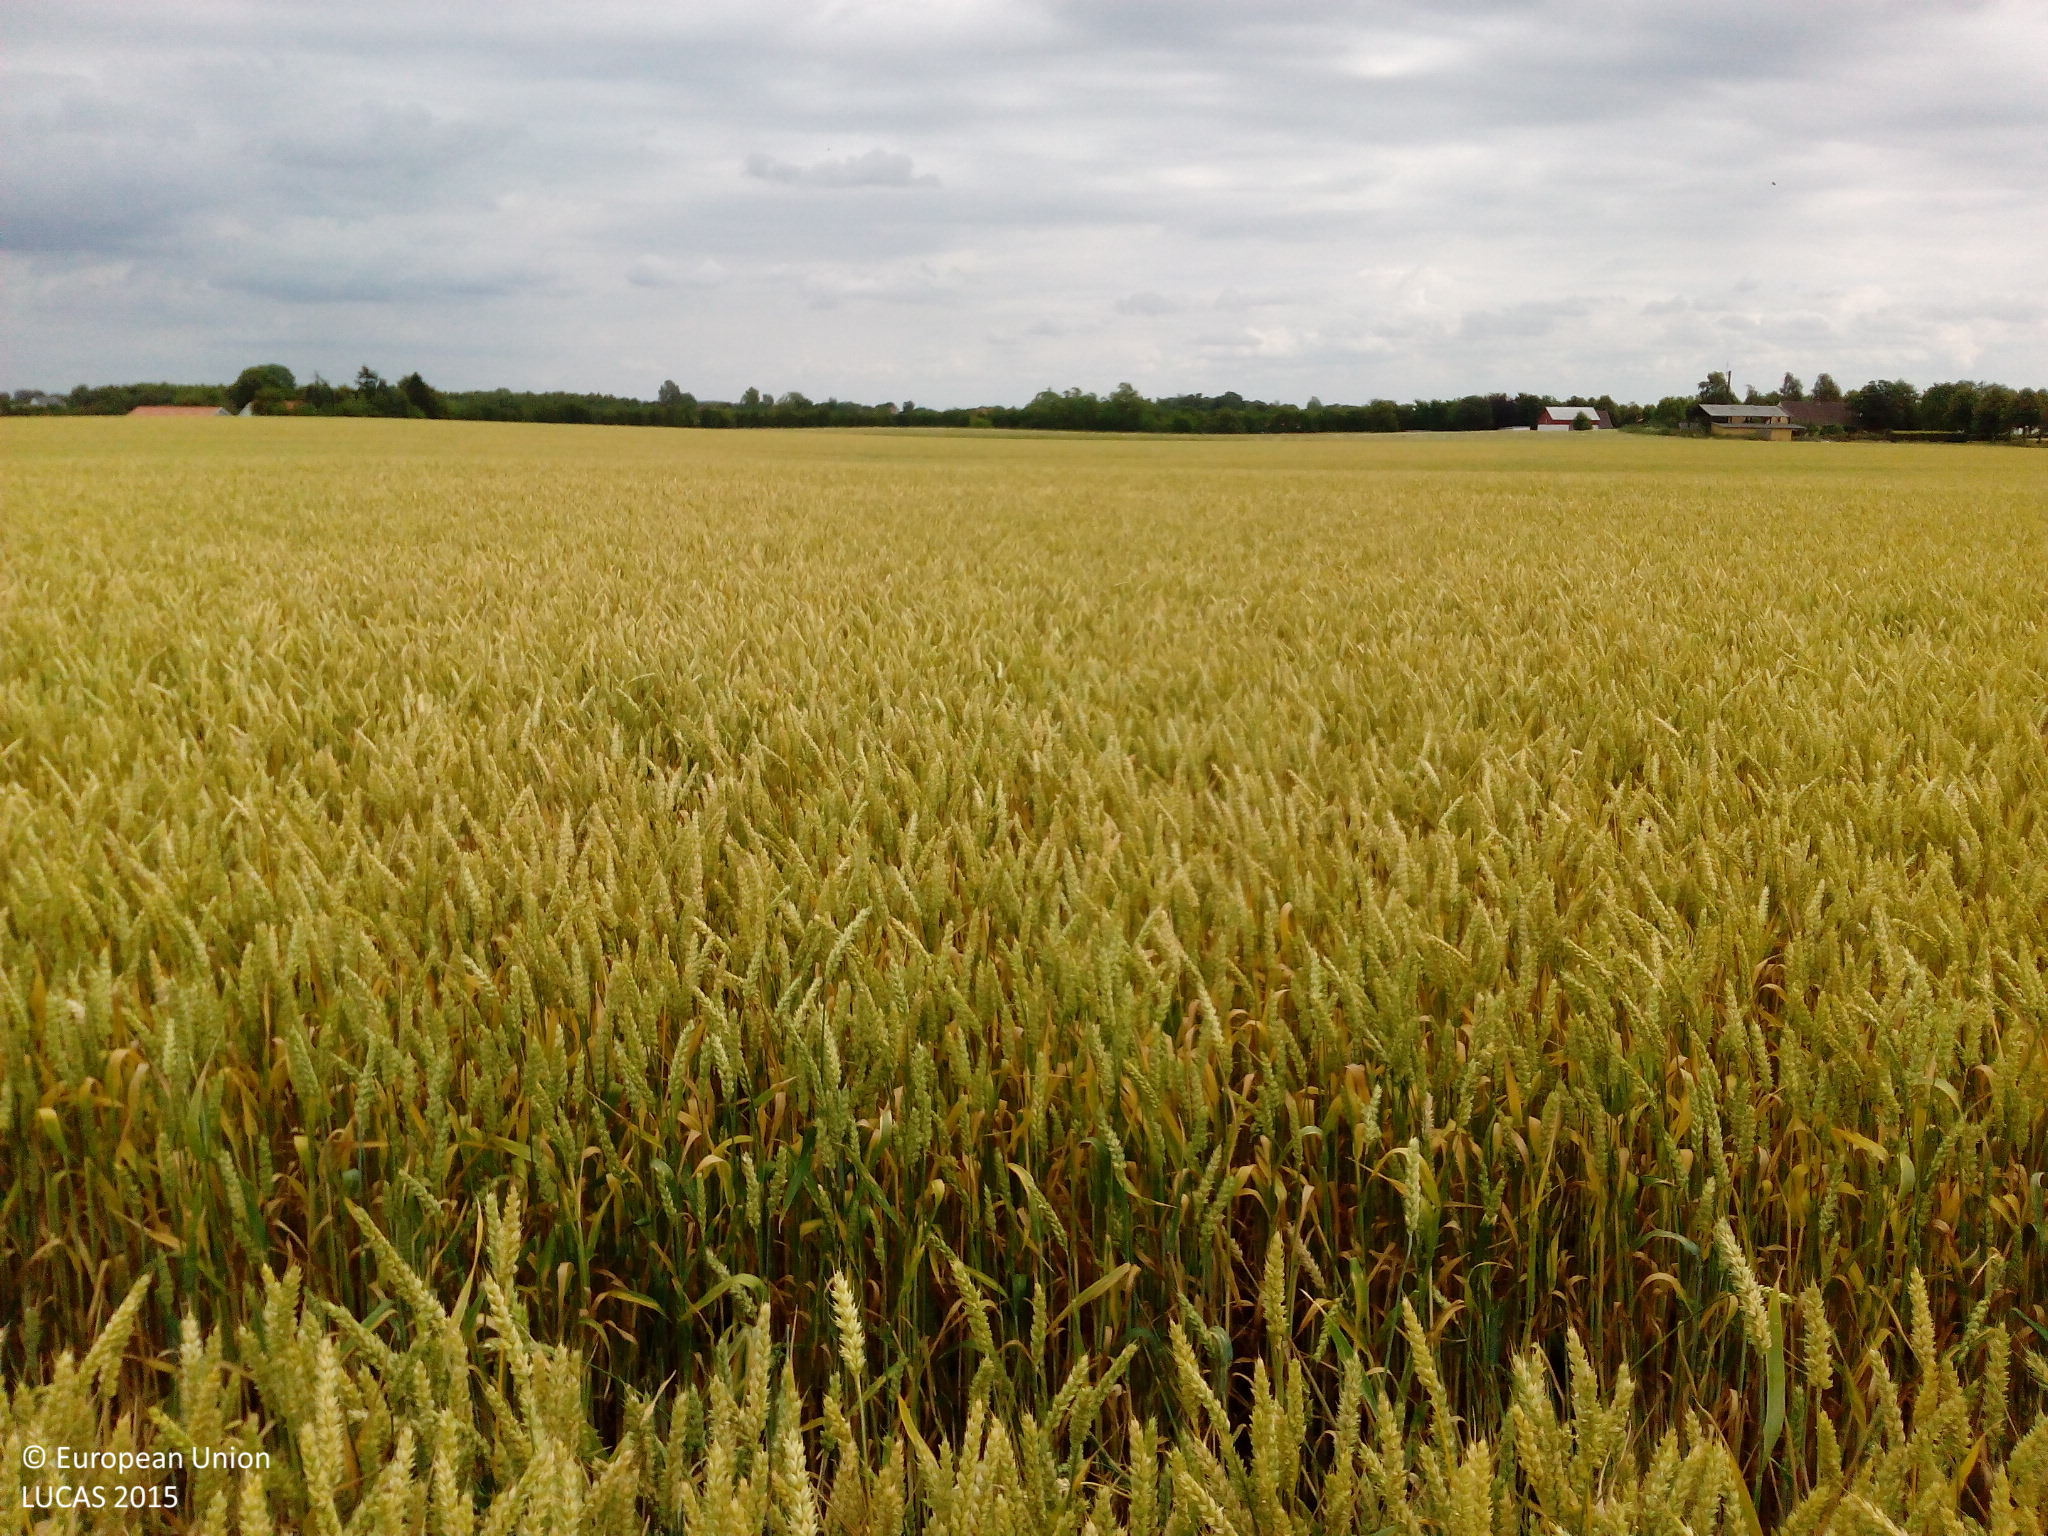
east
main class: Cropland
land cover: Common wheat
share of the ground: > 75 %
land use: Agriculture (excluding fallow land and kitchen gardens)
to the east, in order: Common wheat; Grass margins; Clovers
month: July
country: DK
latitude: 55.6923
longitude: 11.6052
